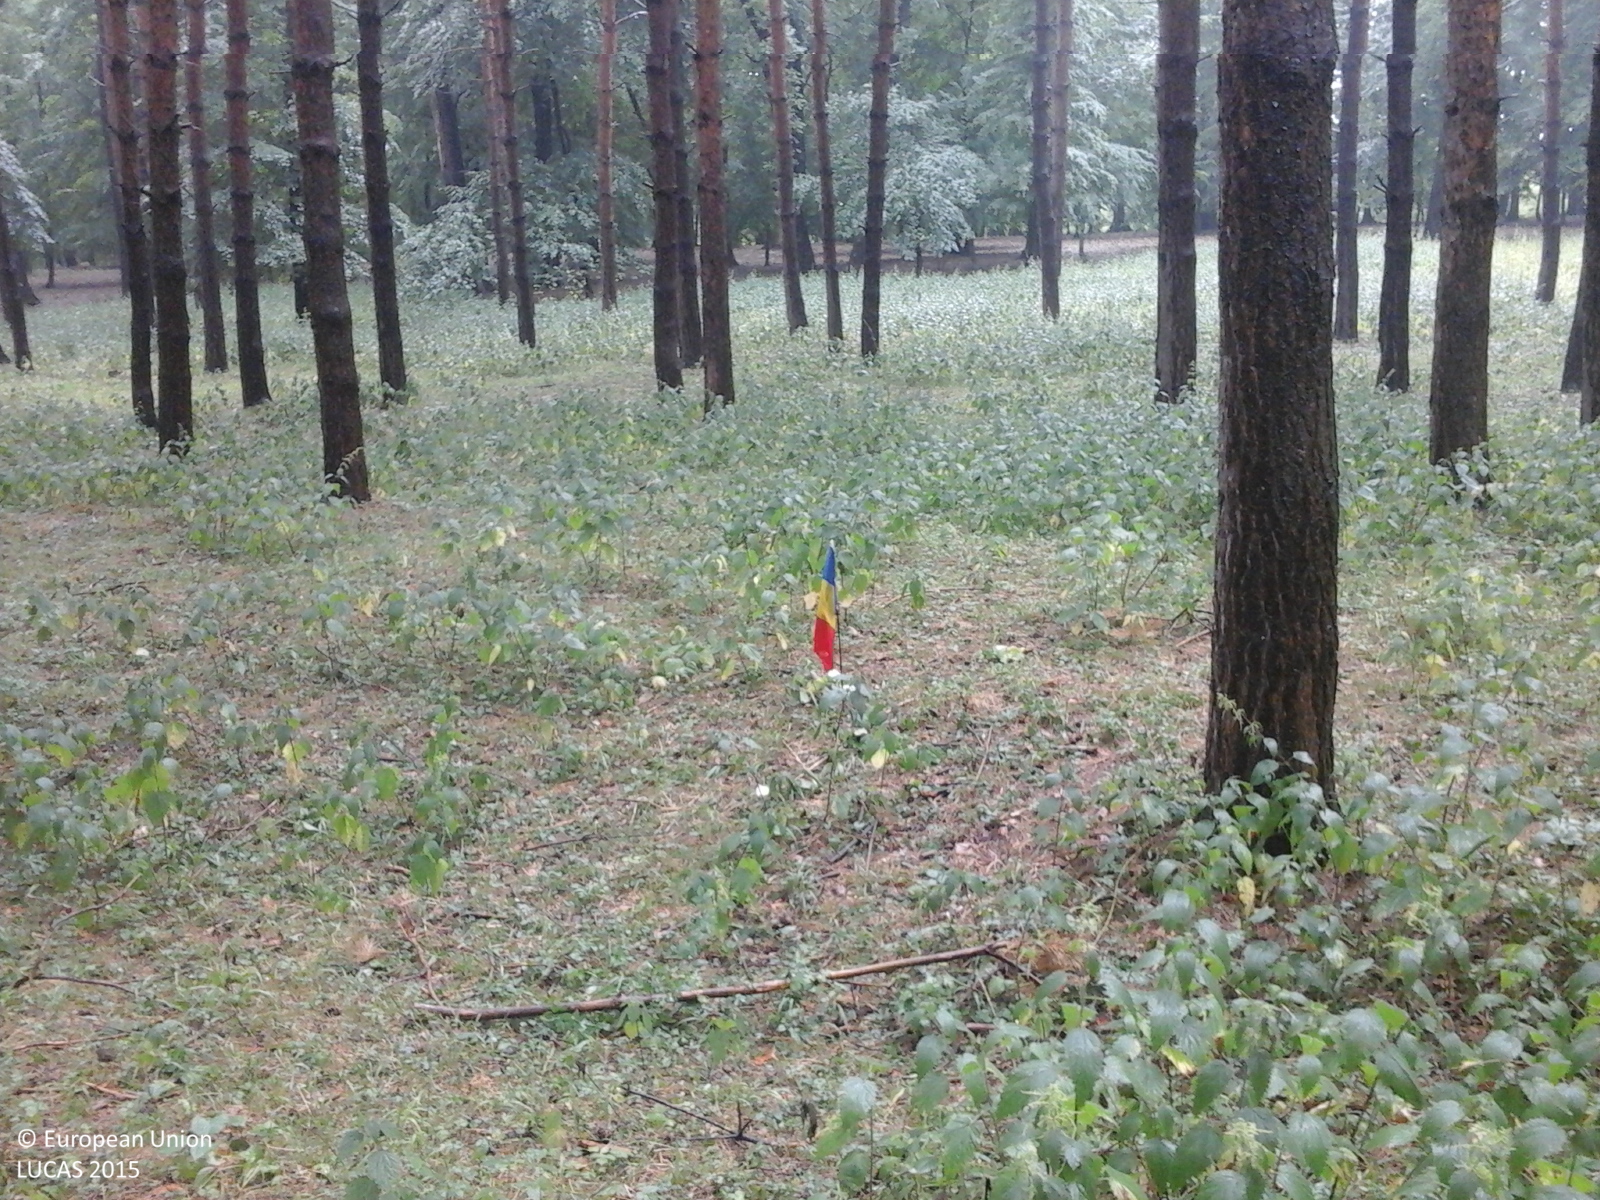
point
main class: Woodland
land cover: Pine dominated coniferous woodland
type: hemiboreal forest and nemoral coniferous forest and mixed broadleaved-coniferous forest
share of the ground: > 75 %
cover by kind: coniferous forest trees 95 %, broadleaved forest trees 5 %
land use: Forestry
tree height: > 5 m
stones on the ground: 10 - 25 %
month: June
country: RO
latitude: 47.3908
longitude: 26.8567
